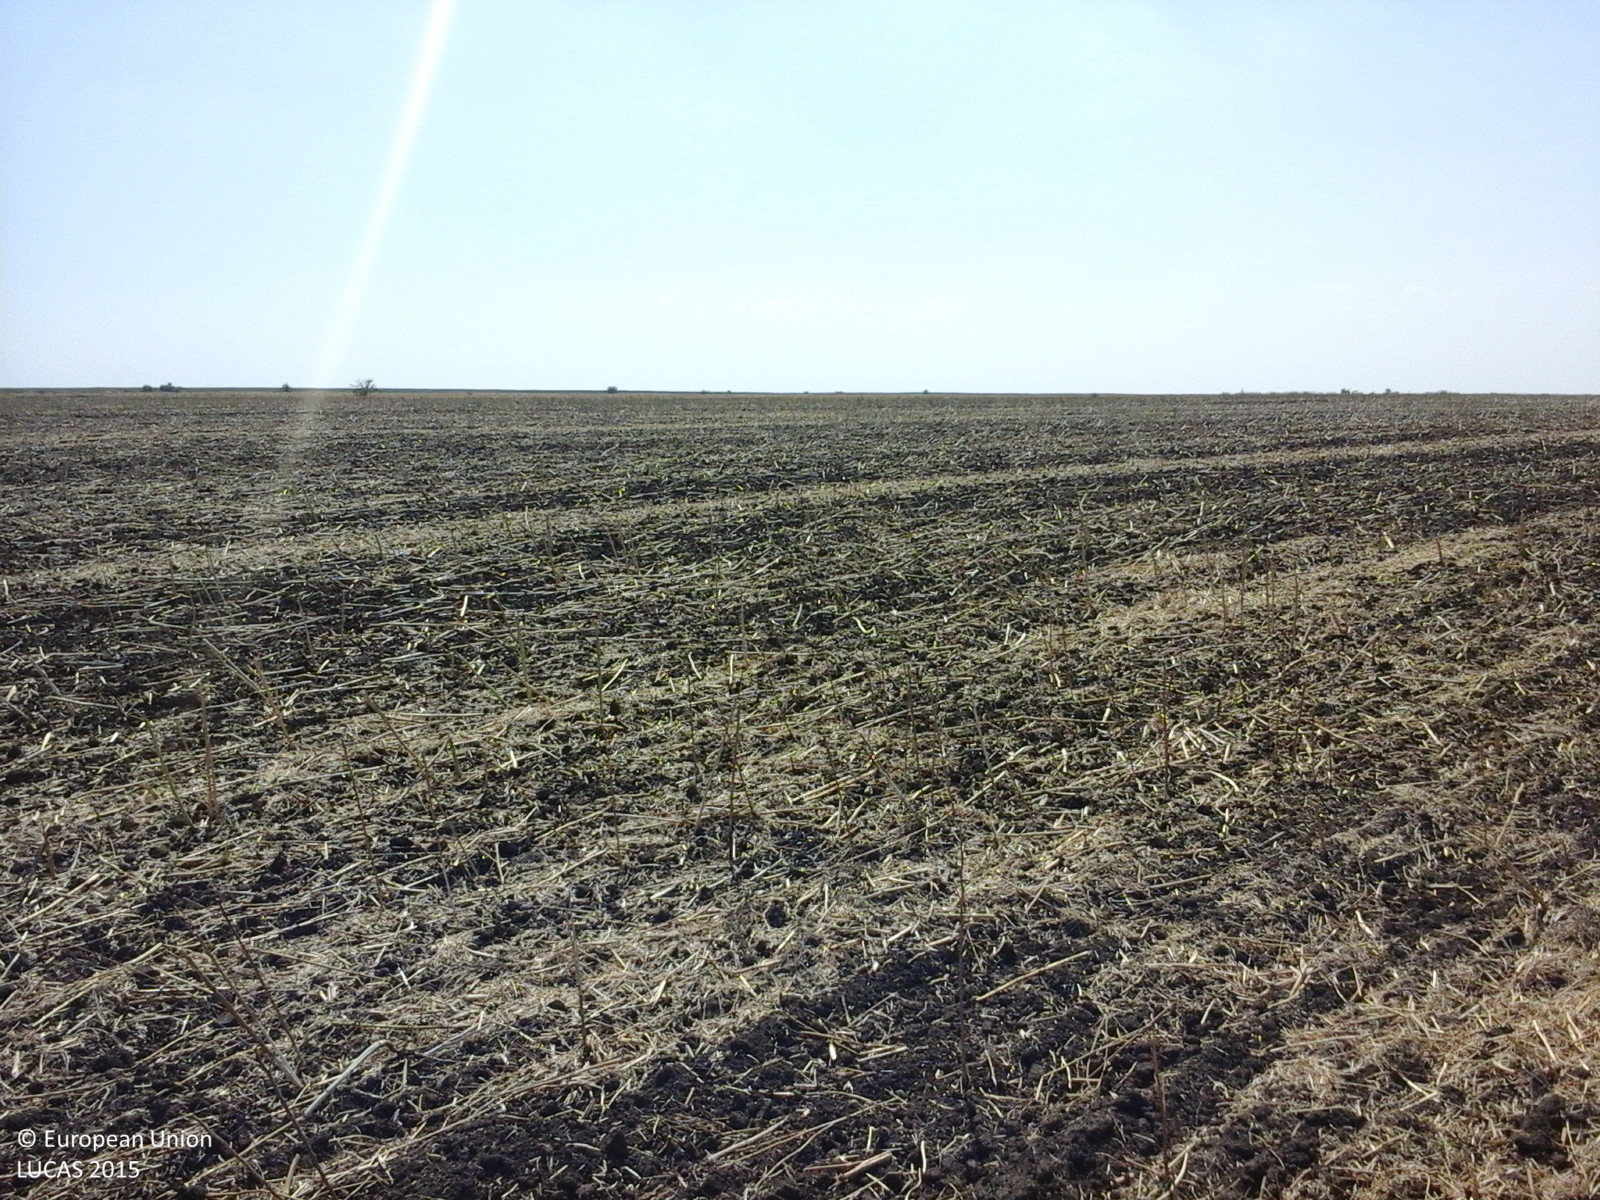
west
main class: Cropland
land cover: Rape and turnip rape
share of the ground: 10 - 25 %
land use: Agriculture (excluding fallow land and kitchen gardens)
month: July
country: RO
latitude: 44.3047
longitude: 27.0635
